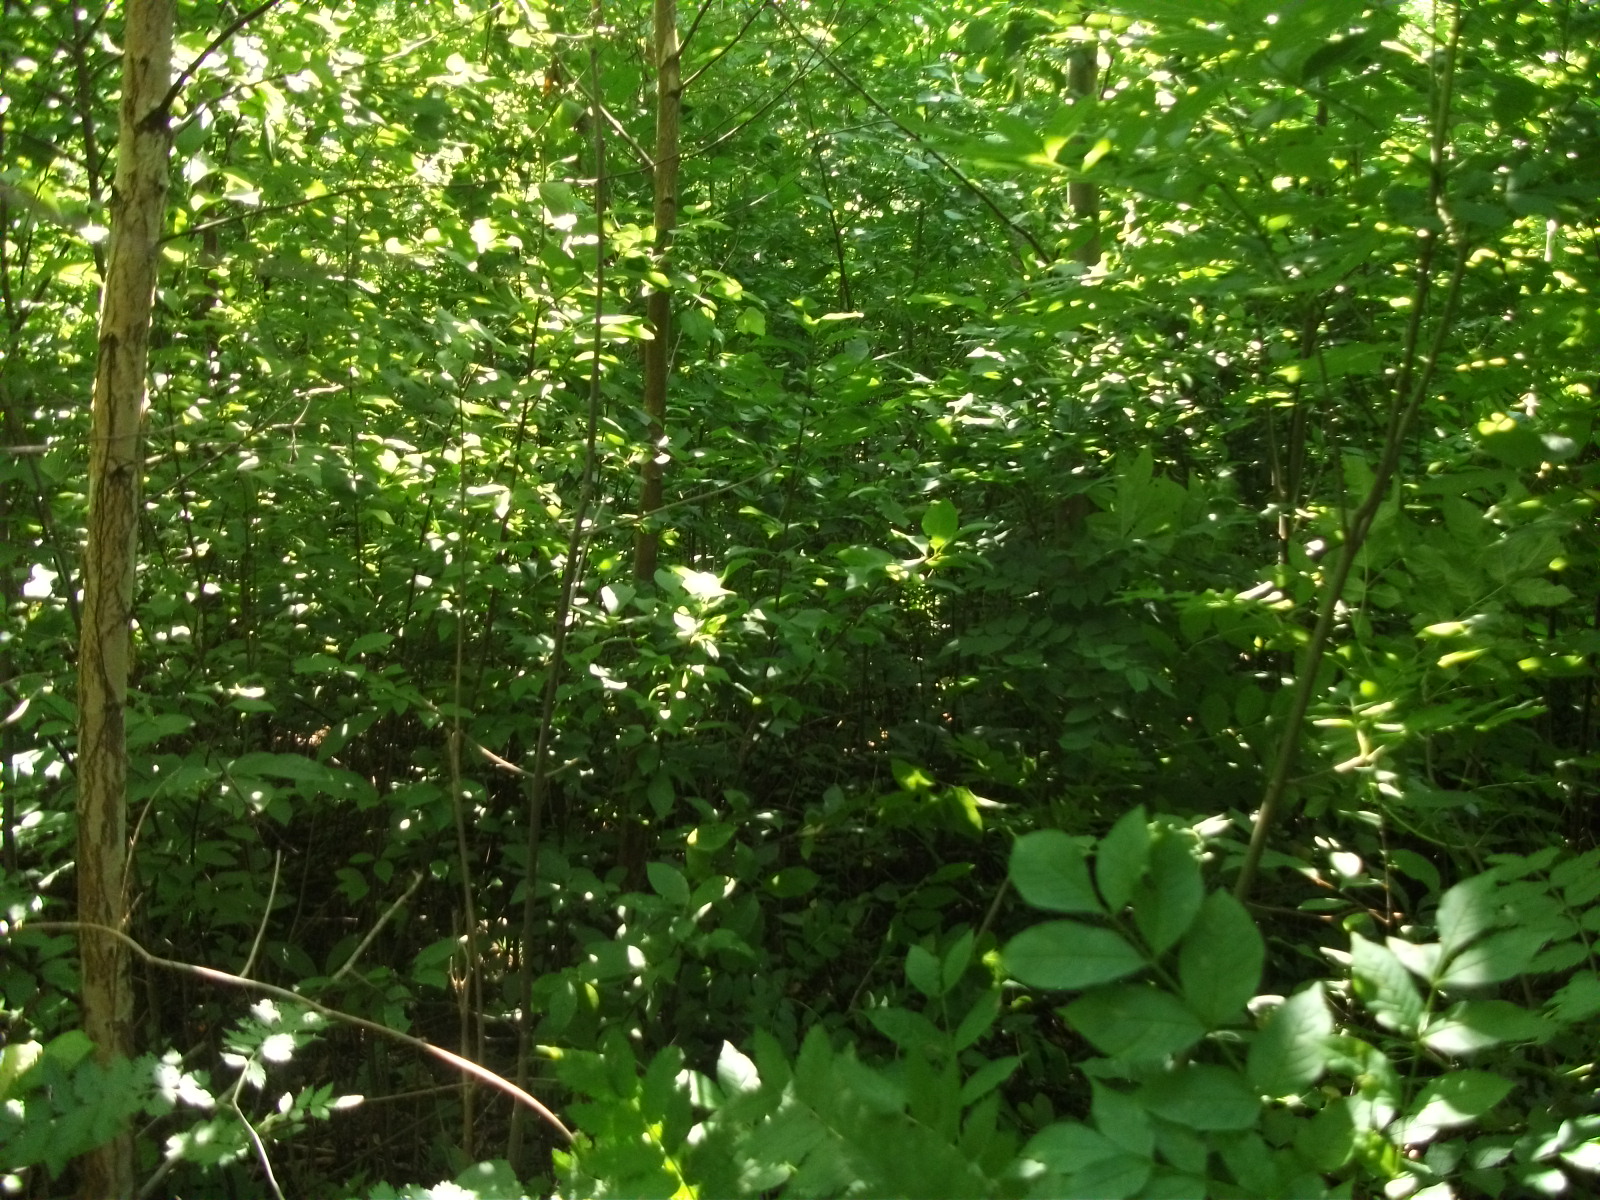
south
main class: Woodland
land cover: Broadleaved woodland
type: non-riverine alder, birch or aspen forest
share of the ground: > 75 %
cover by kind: broadleaved forest trees 100 %
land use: Forestry
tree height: > 5 m
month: July
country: LV
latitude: 57.0295
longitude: 26.3021
